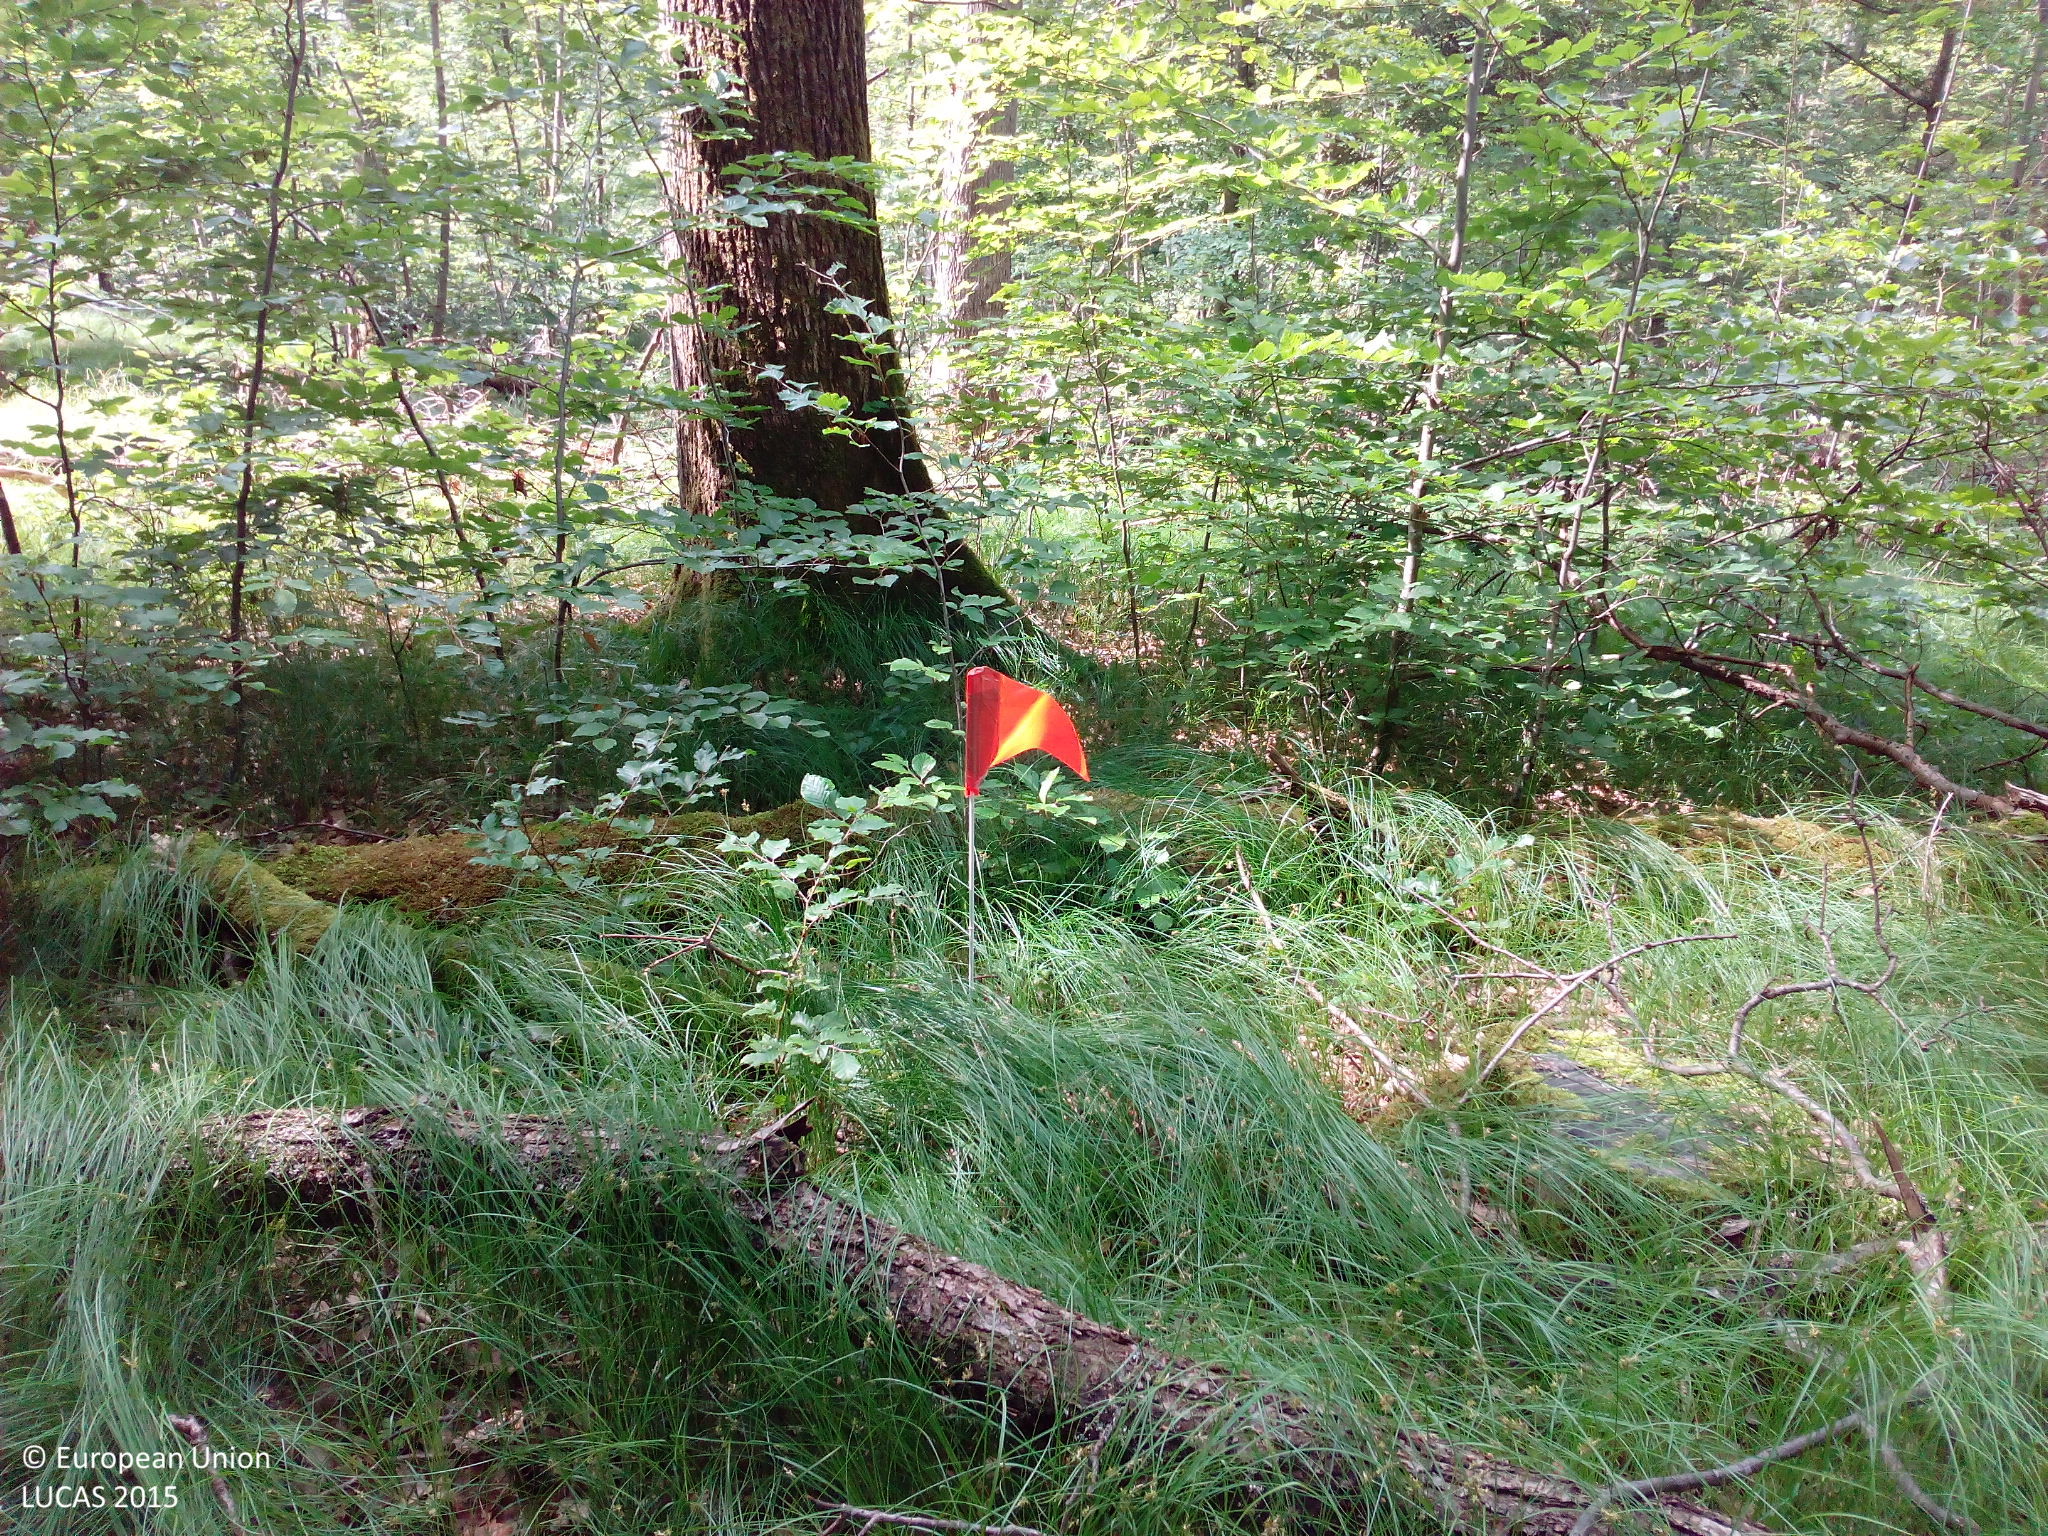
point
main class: Woodland
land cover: Broadleaved woodland
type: mesophytic deciduous forest
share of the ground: > 75 %
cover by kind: broadleaved forest trees 85 %, shrubs 10 %, herbaceous plants 5 %
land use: Forestry
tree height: > 5 m
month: June
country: DE
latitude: 48.7438
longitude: 9.4155
